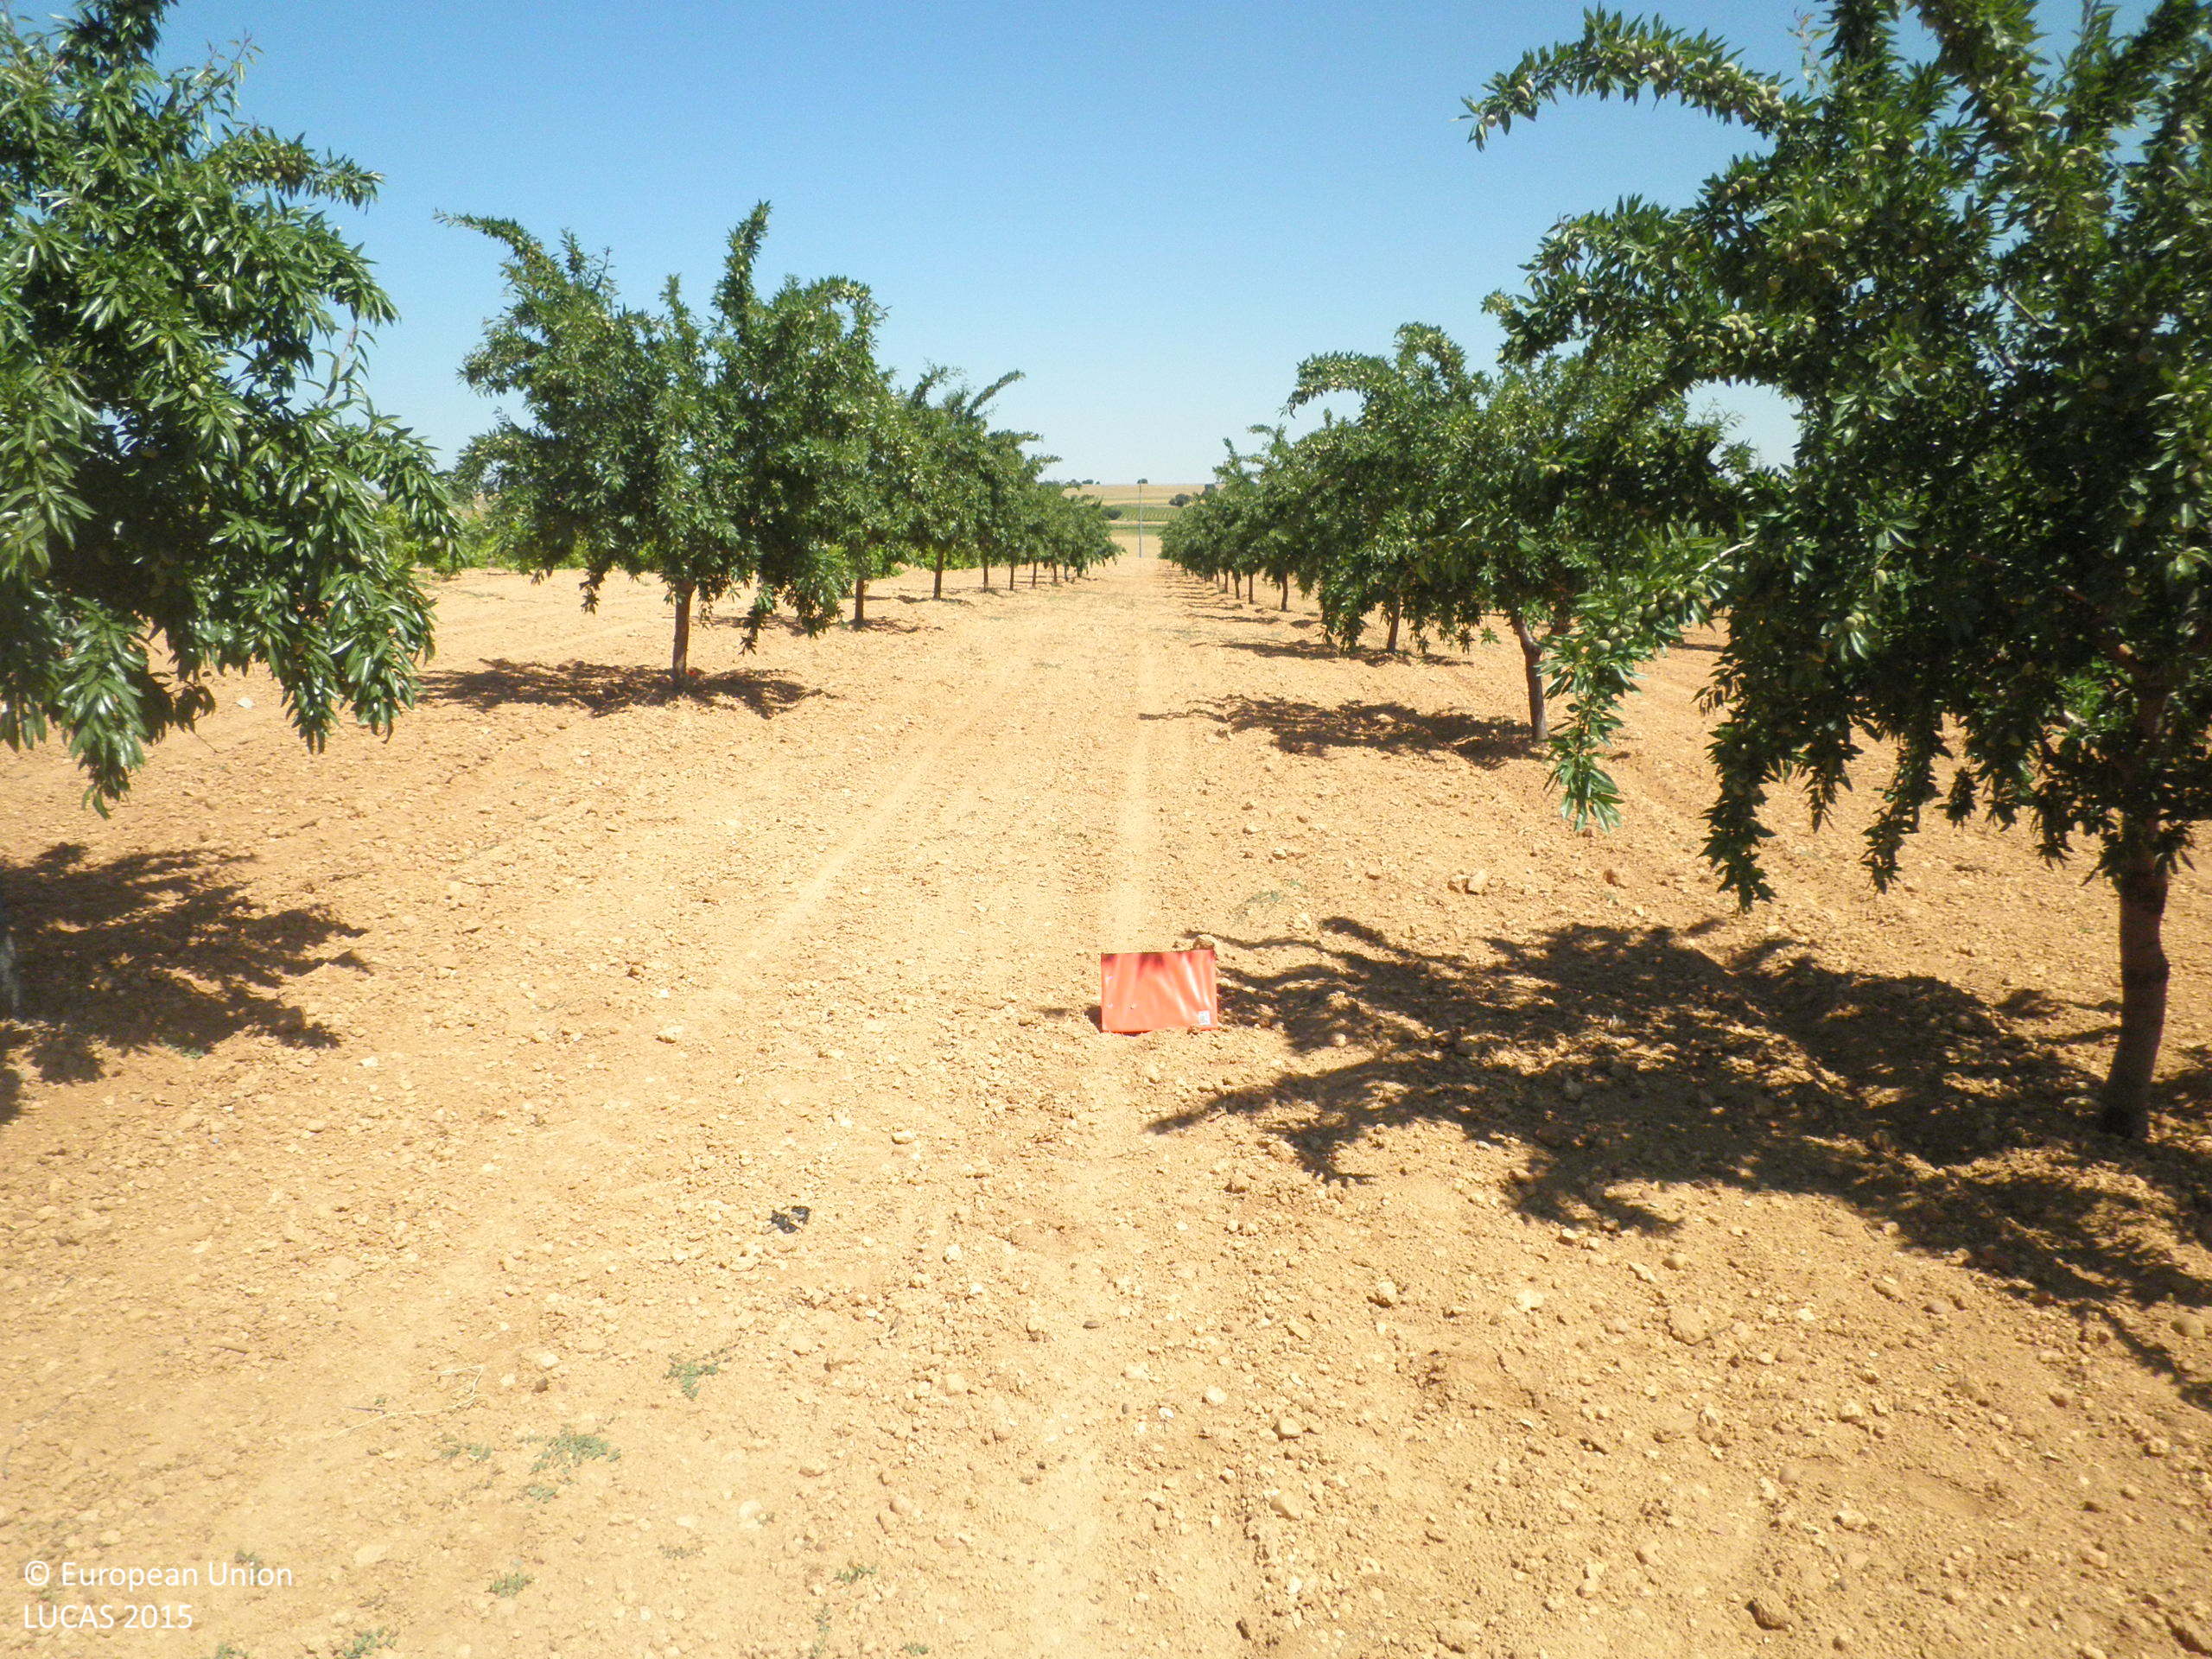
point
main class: Cropland
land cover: Nuts trees
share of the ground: 10 - 25 %
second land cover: Other bare soil
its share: > 75 %
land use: Agriculture (excluding fallow land and kitchen gardens)
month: June
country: ES
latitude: 39.3866
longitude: -1.8124
